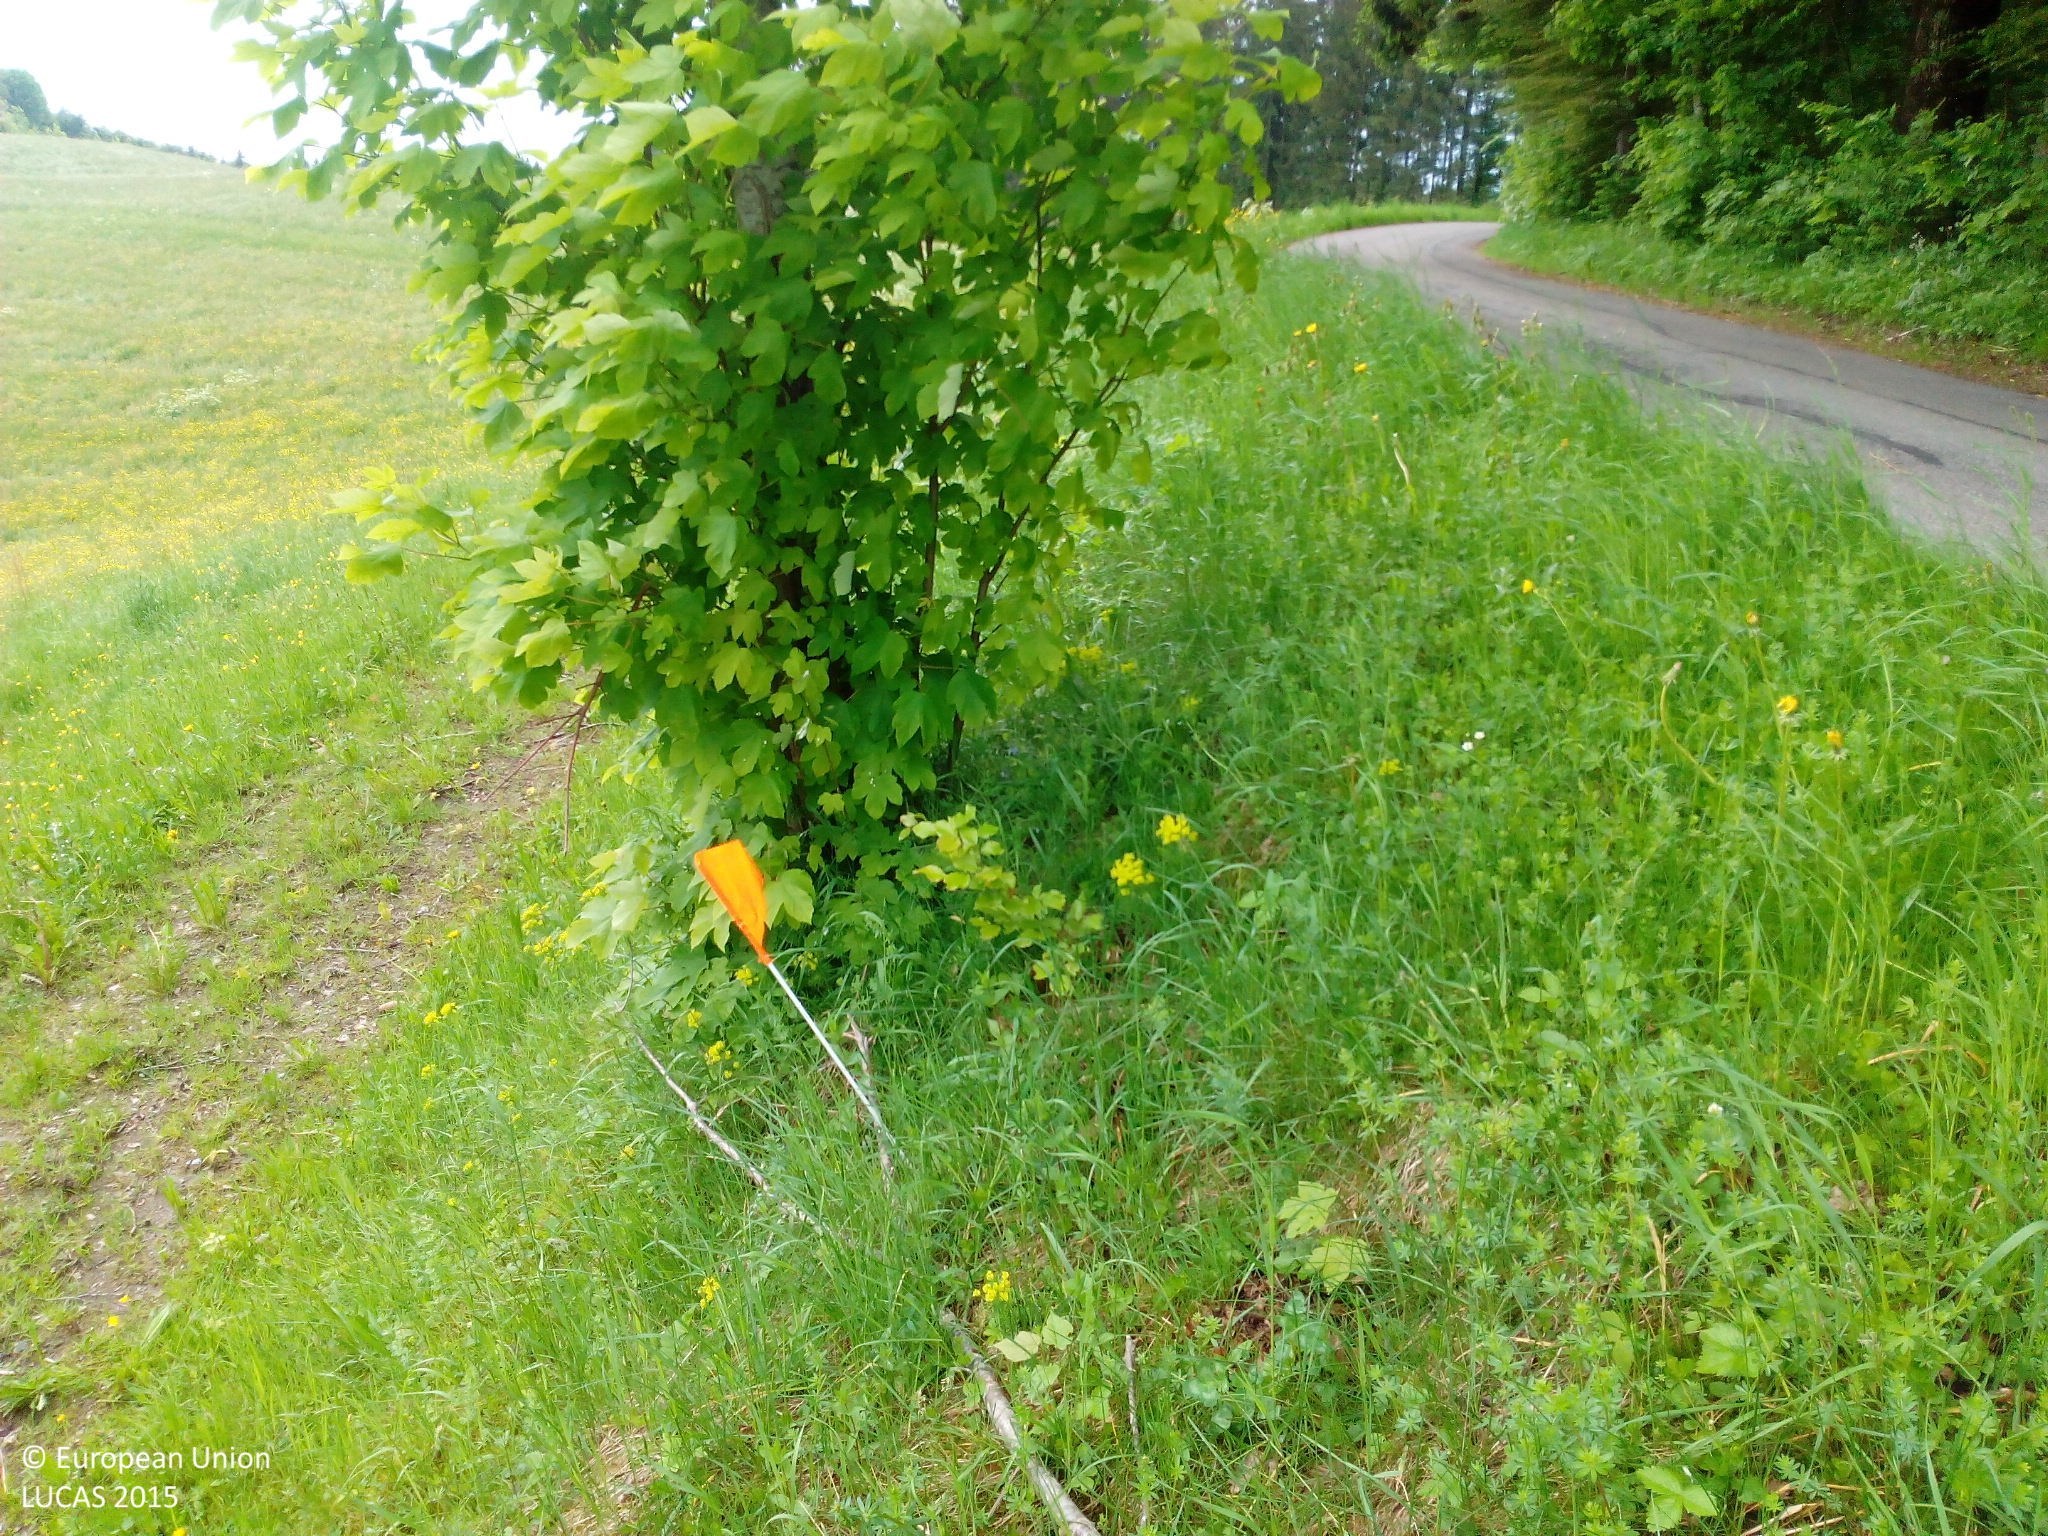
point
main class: Grassland
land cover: Grassland without tree/shrub cover
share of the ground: > 75 %
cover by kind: herbaceous plants 100 %
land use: Agriculture (excluding fallow land and kitchen gardens)
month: May
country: DE
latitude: 47.8275
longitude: 9.8532
